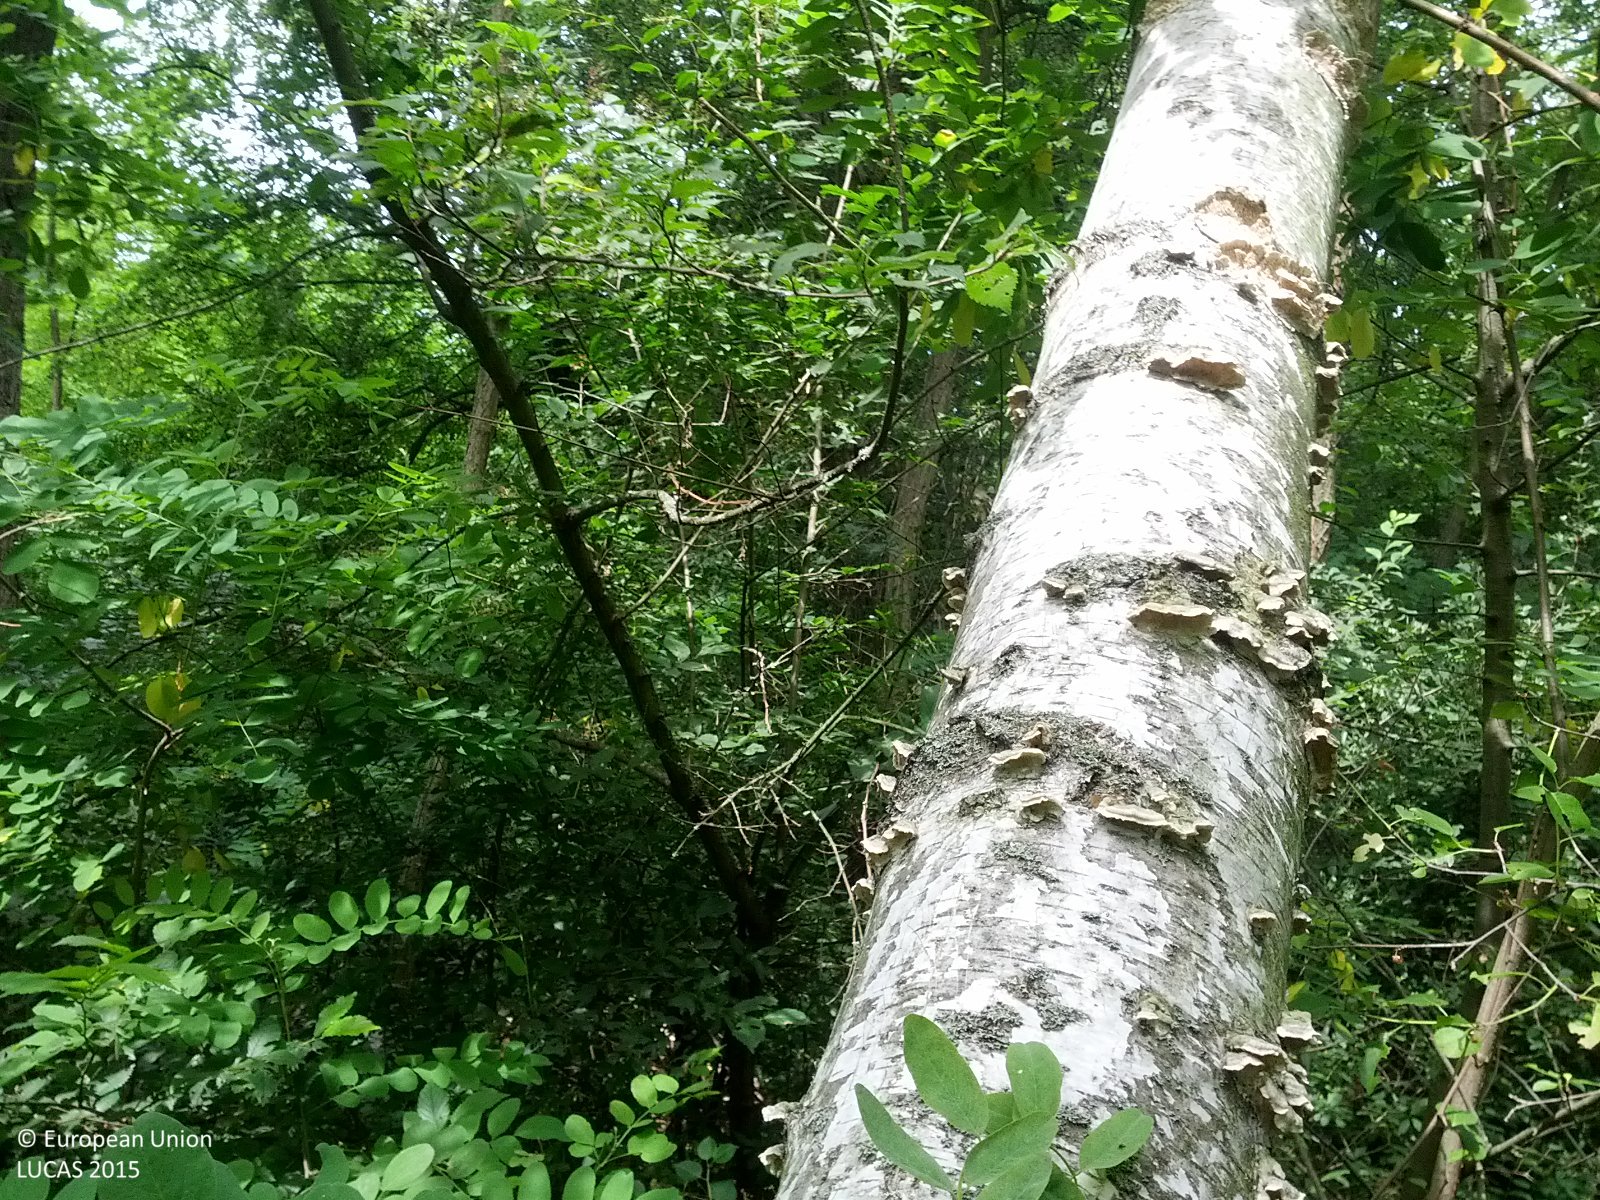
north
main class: Woodland
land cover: Broadleaved woodland
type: acidophilous oak and oak-birch forest
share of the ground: 50 - 75 %
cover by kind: broadleaved forest trees 65 %, shrubs 20 %, herbaceous plants 15 %
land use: Forestry
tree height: > 5 m
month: June
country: AT
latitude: 48.3309
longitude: 16.6293
